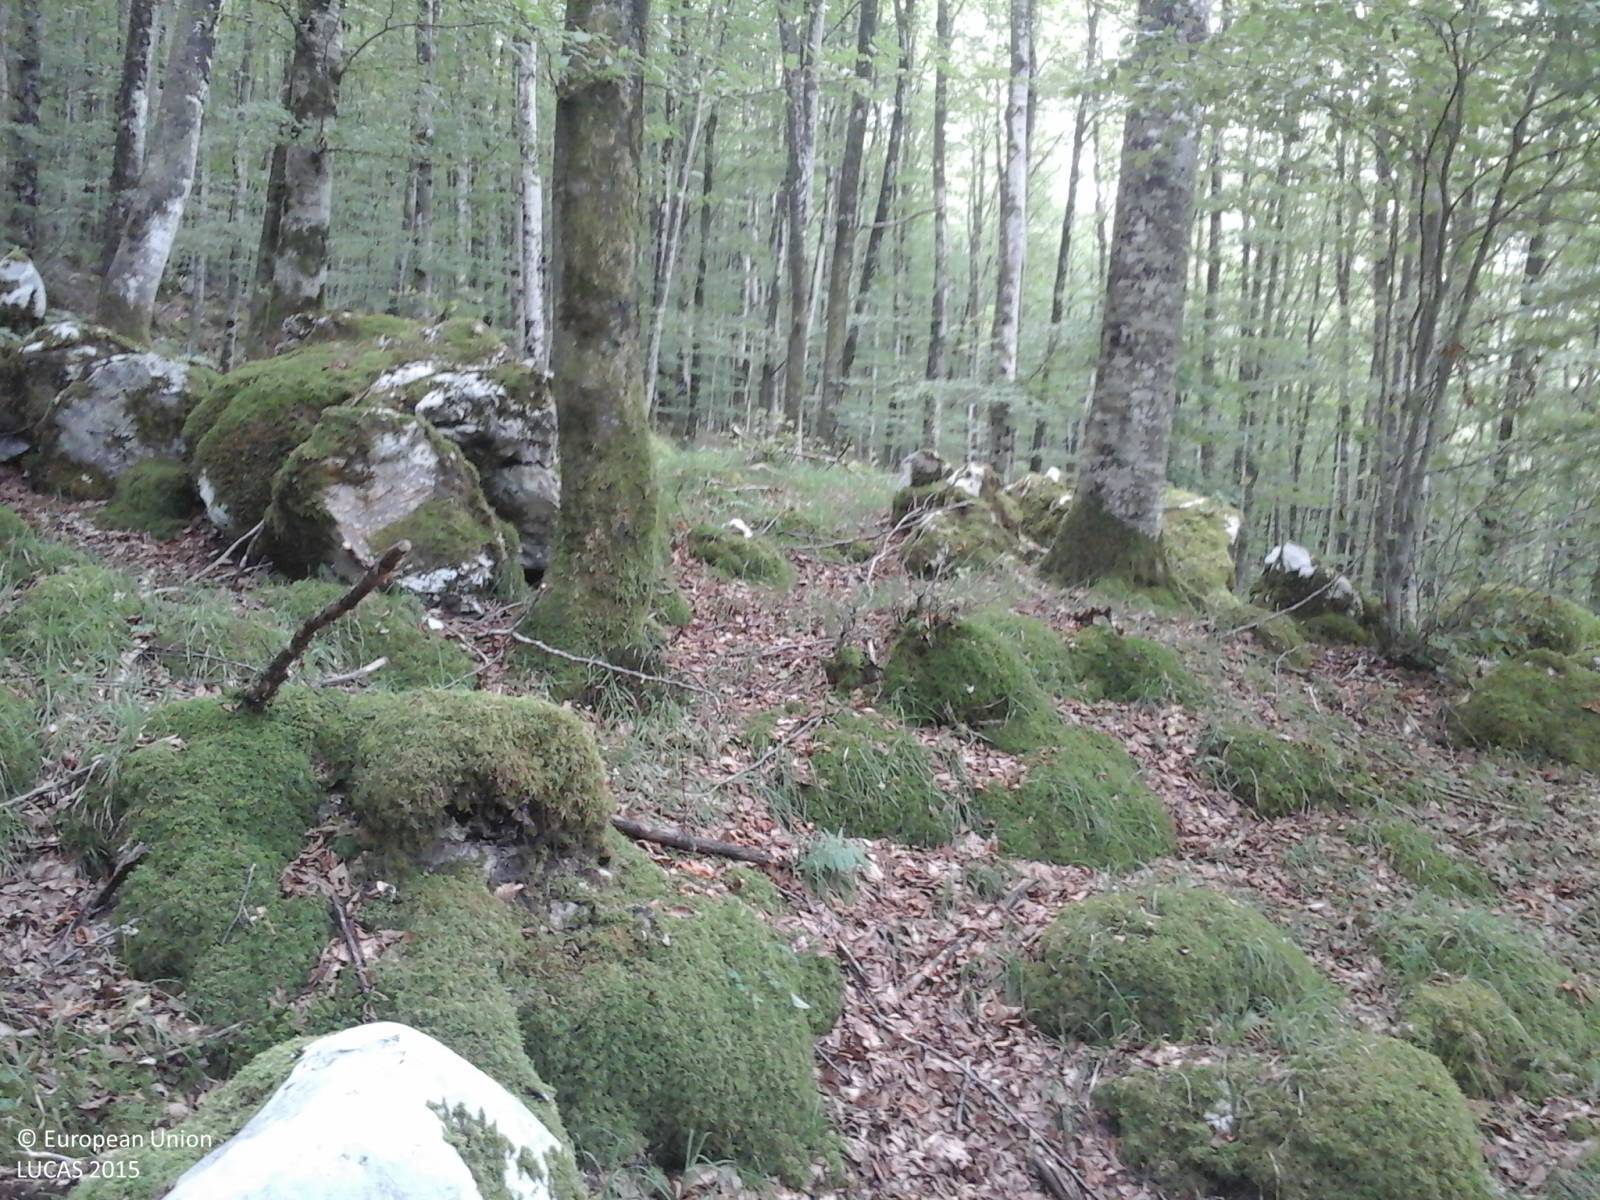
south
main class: Woodland
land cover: Broadleaved woodland
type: mountainous beech forest
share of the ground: > 75 %
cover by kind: broadleaved forest trees 100 %
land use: Forestry
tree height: > 5 m
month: July
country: IT
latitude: 46.1767
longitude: 12.5488
